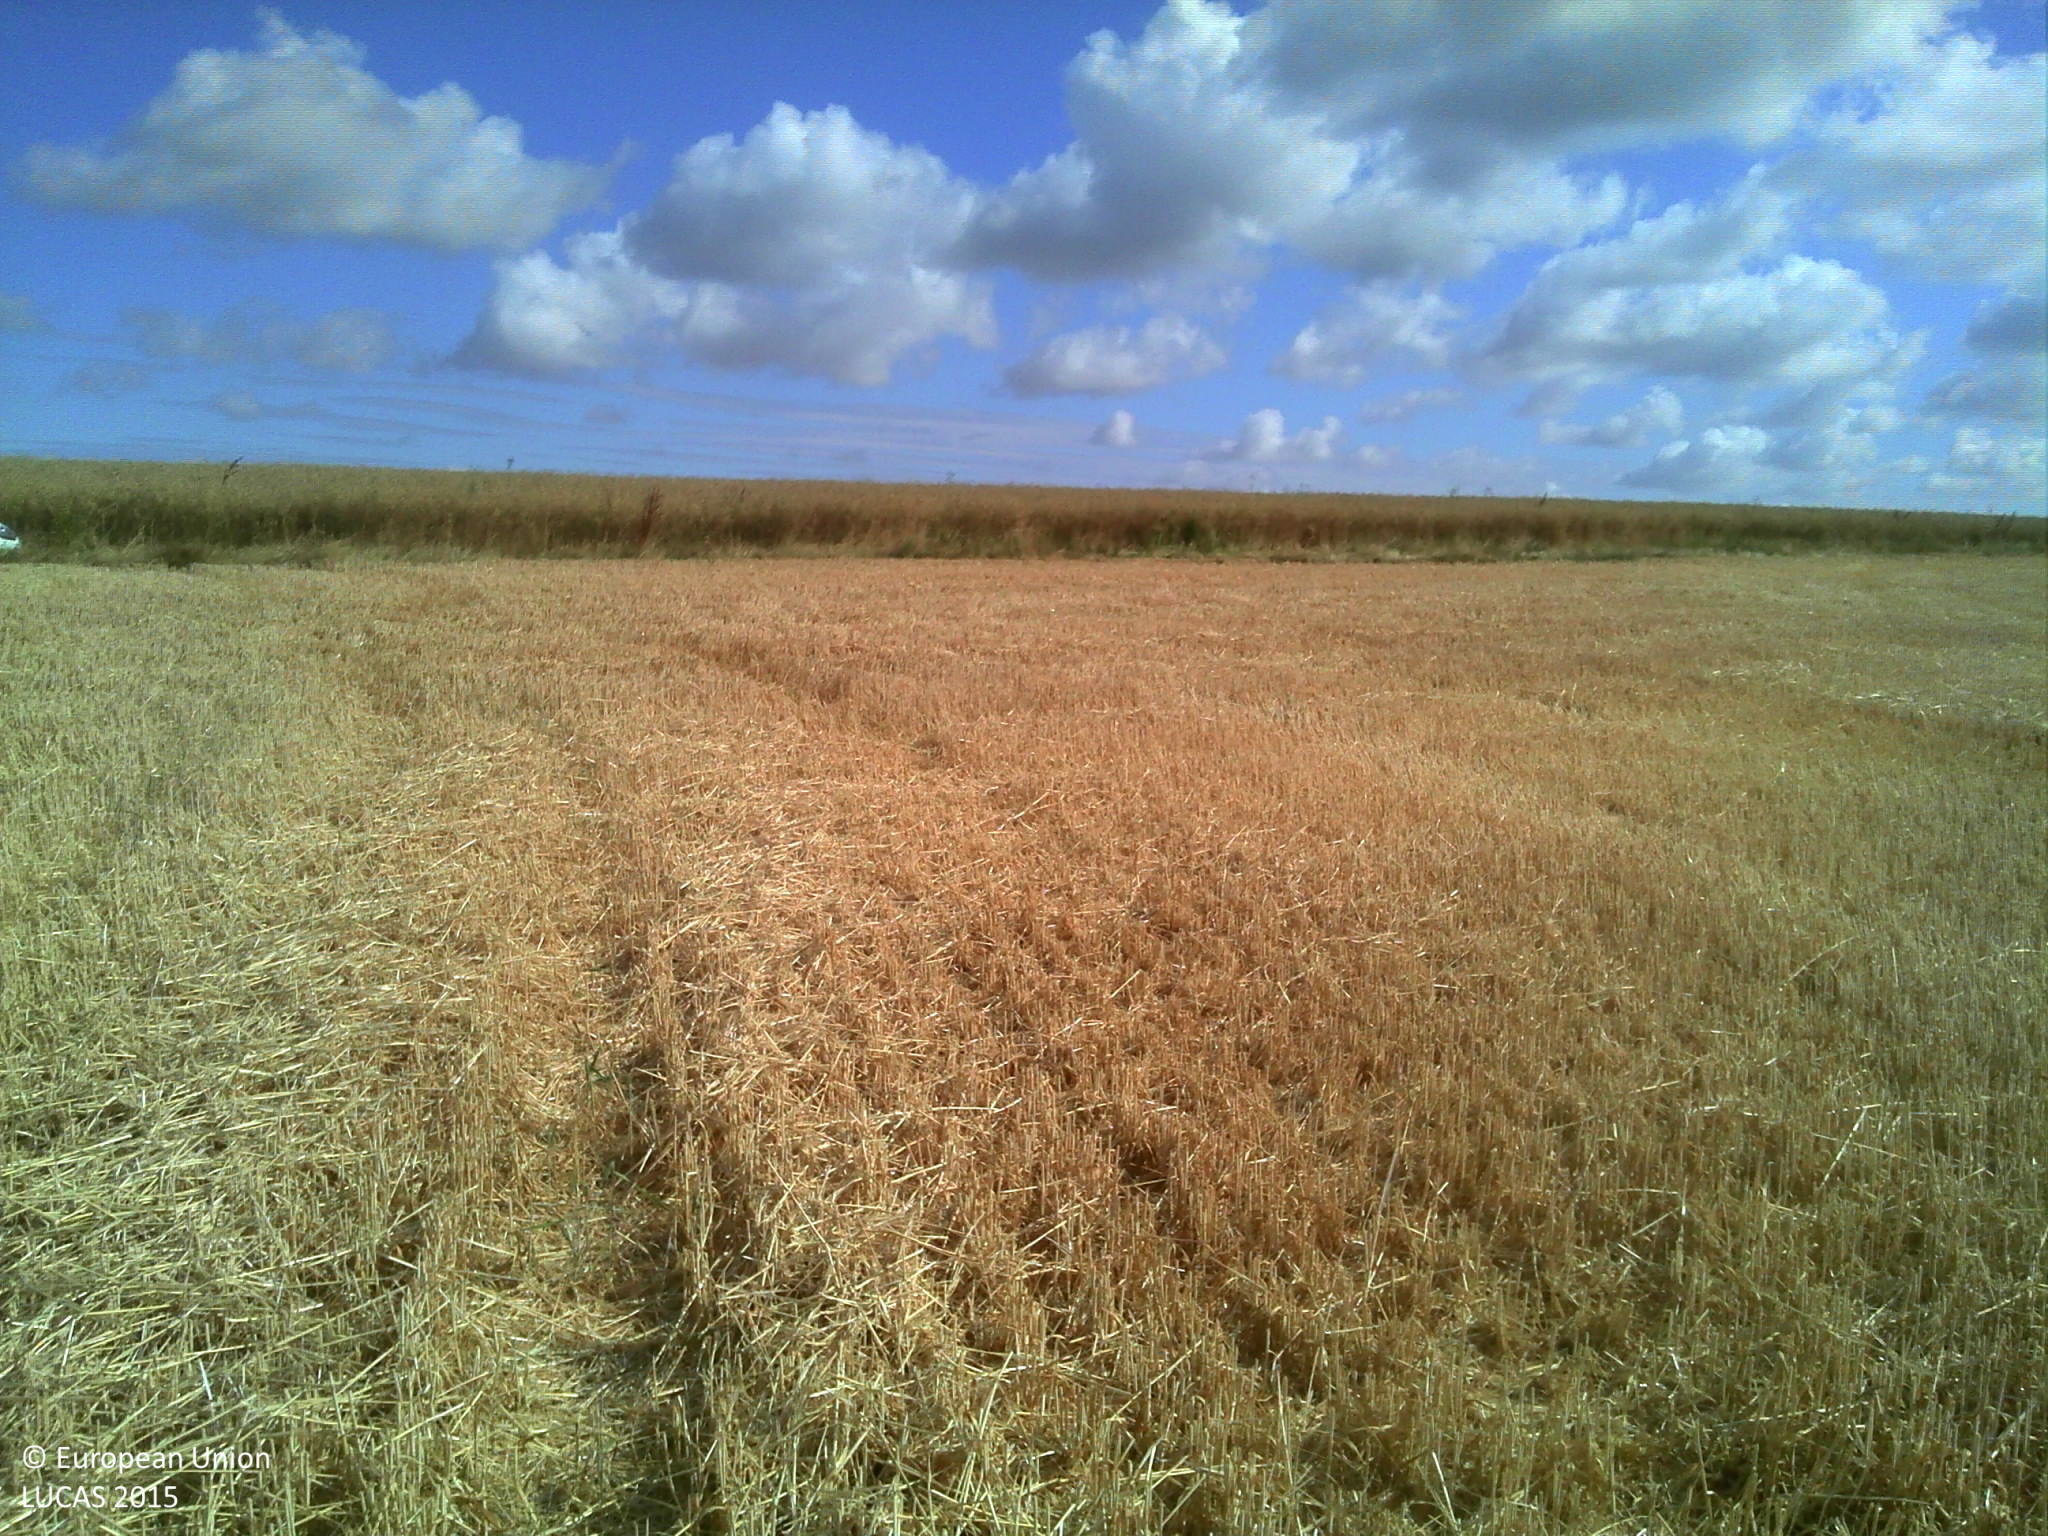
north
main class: Cropland
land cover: Common wheat
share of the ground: > 75 %
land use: Agriculture (excluding fallow land and kitchen gardens)
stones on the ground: 10 - 25 %
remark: Harvested field
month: July
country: FR
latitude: 48.2608
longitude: 3.4070
